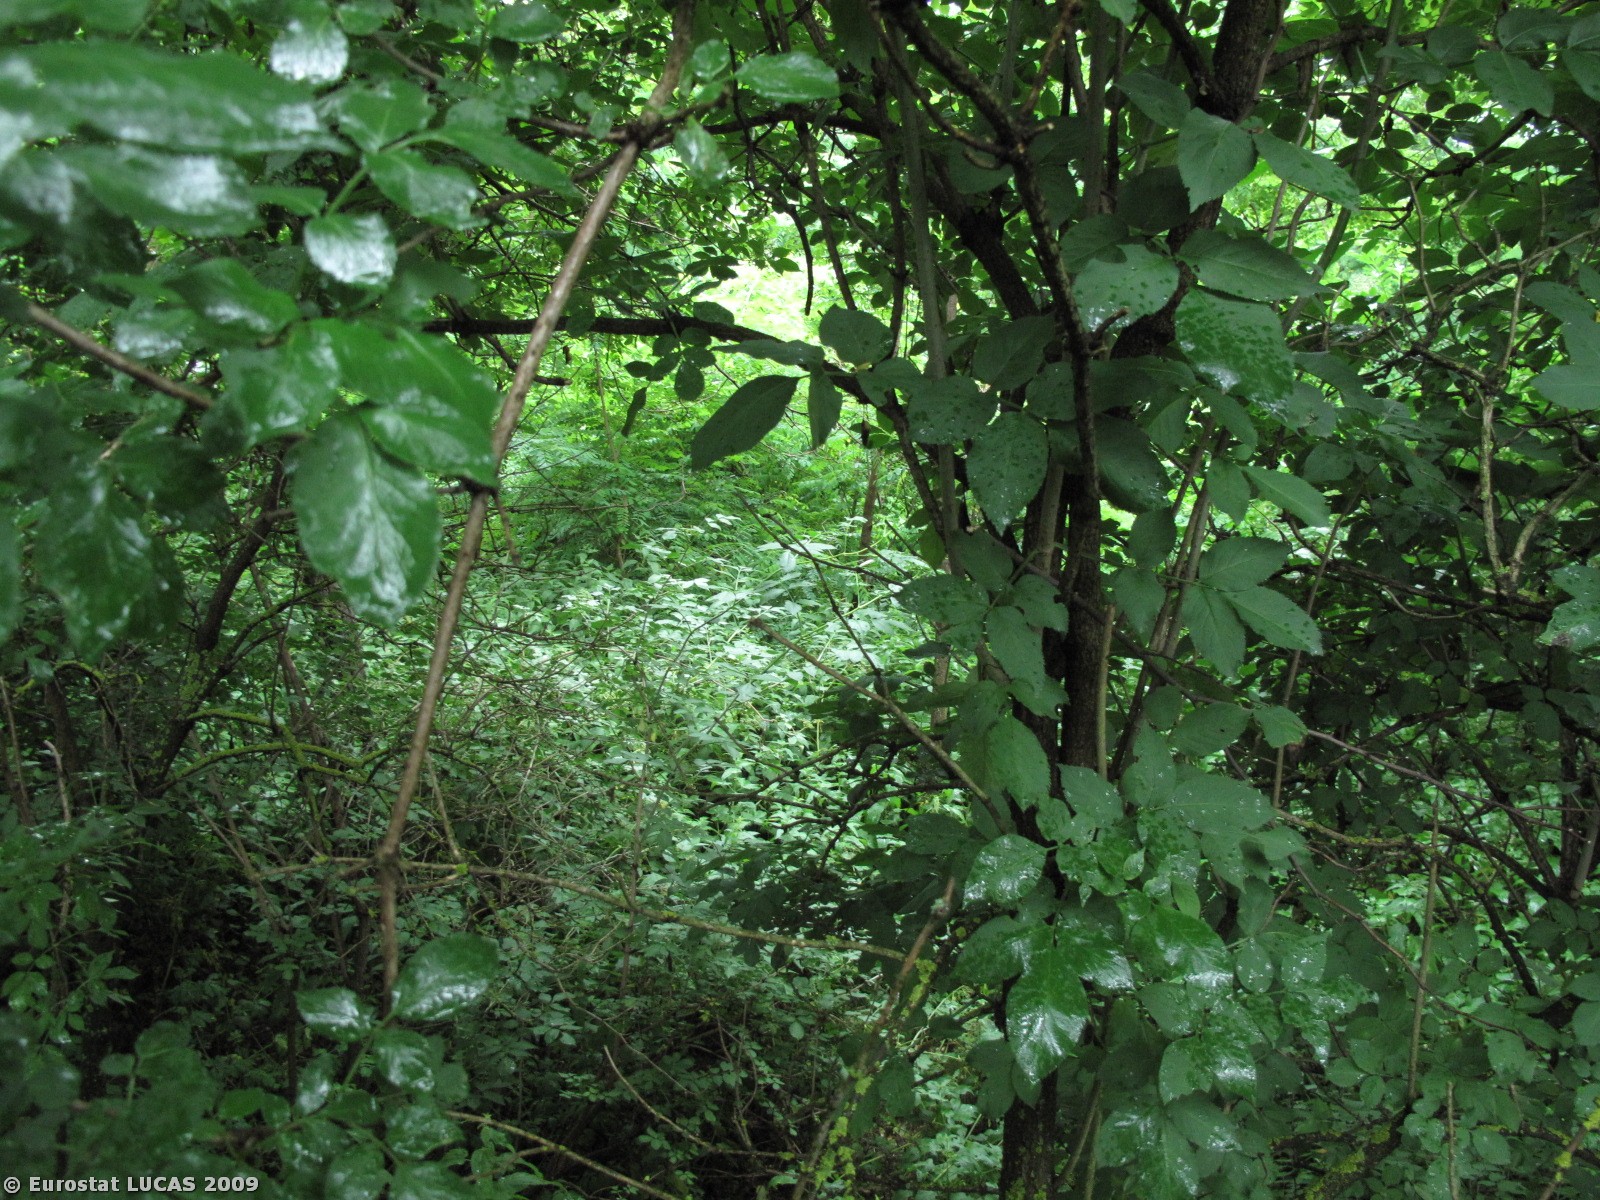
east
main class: Woodland
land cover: Broadleaved woodland
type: mesophytic deciduous forest
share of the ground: > 75 %
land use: Unused
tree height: > 5 m
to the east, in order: Broadleaved woodland; Maize; Abandoned hedges; Grassland without tree/shrub cover; Shrubland with sparse tree cover; Barley
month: June
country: AT
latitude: 48.2659
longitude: 15.8637
